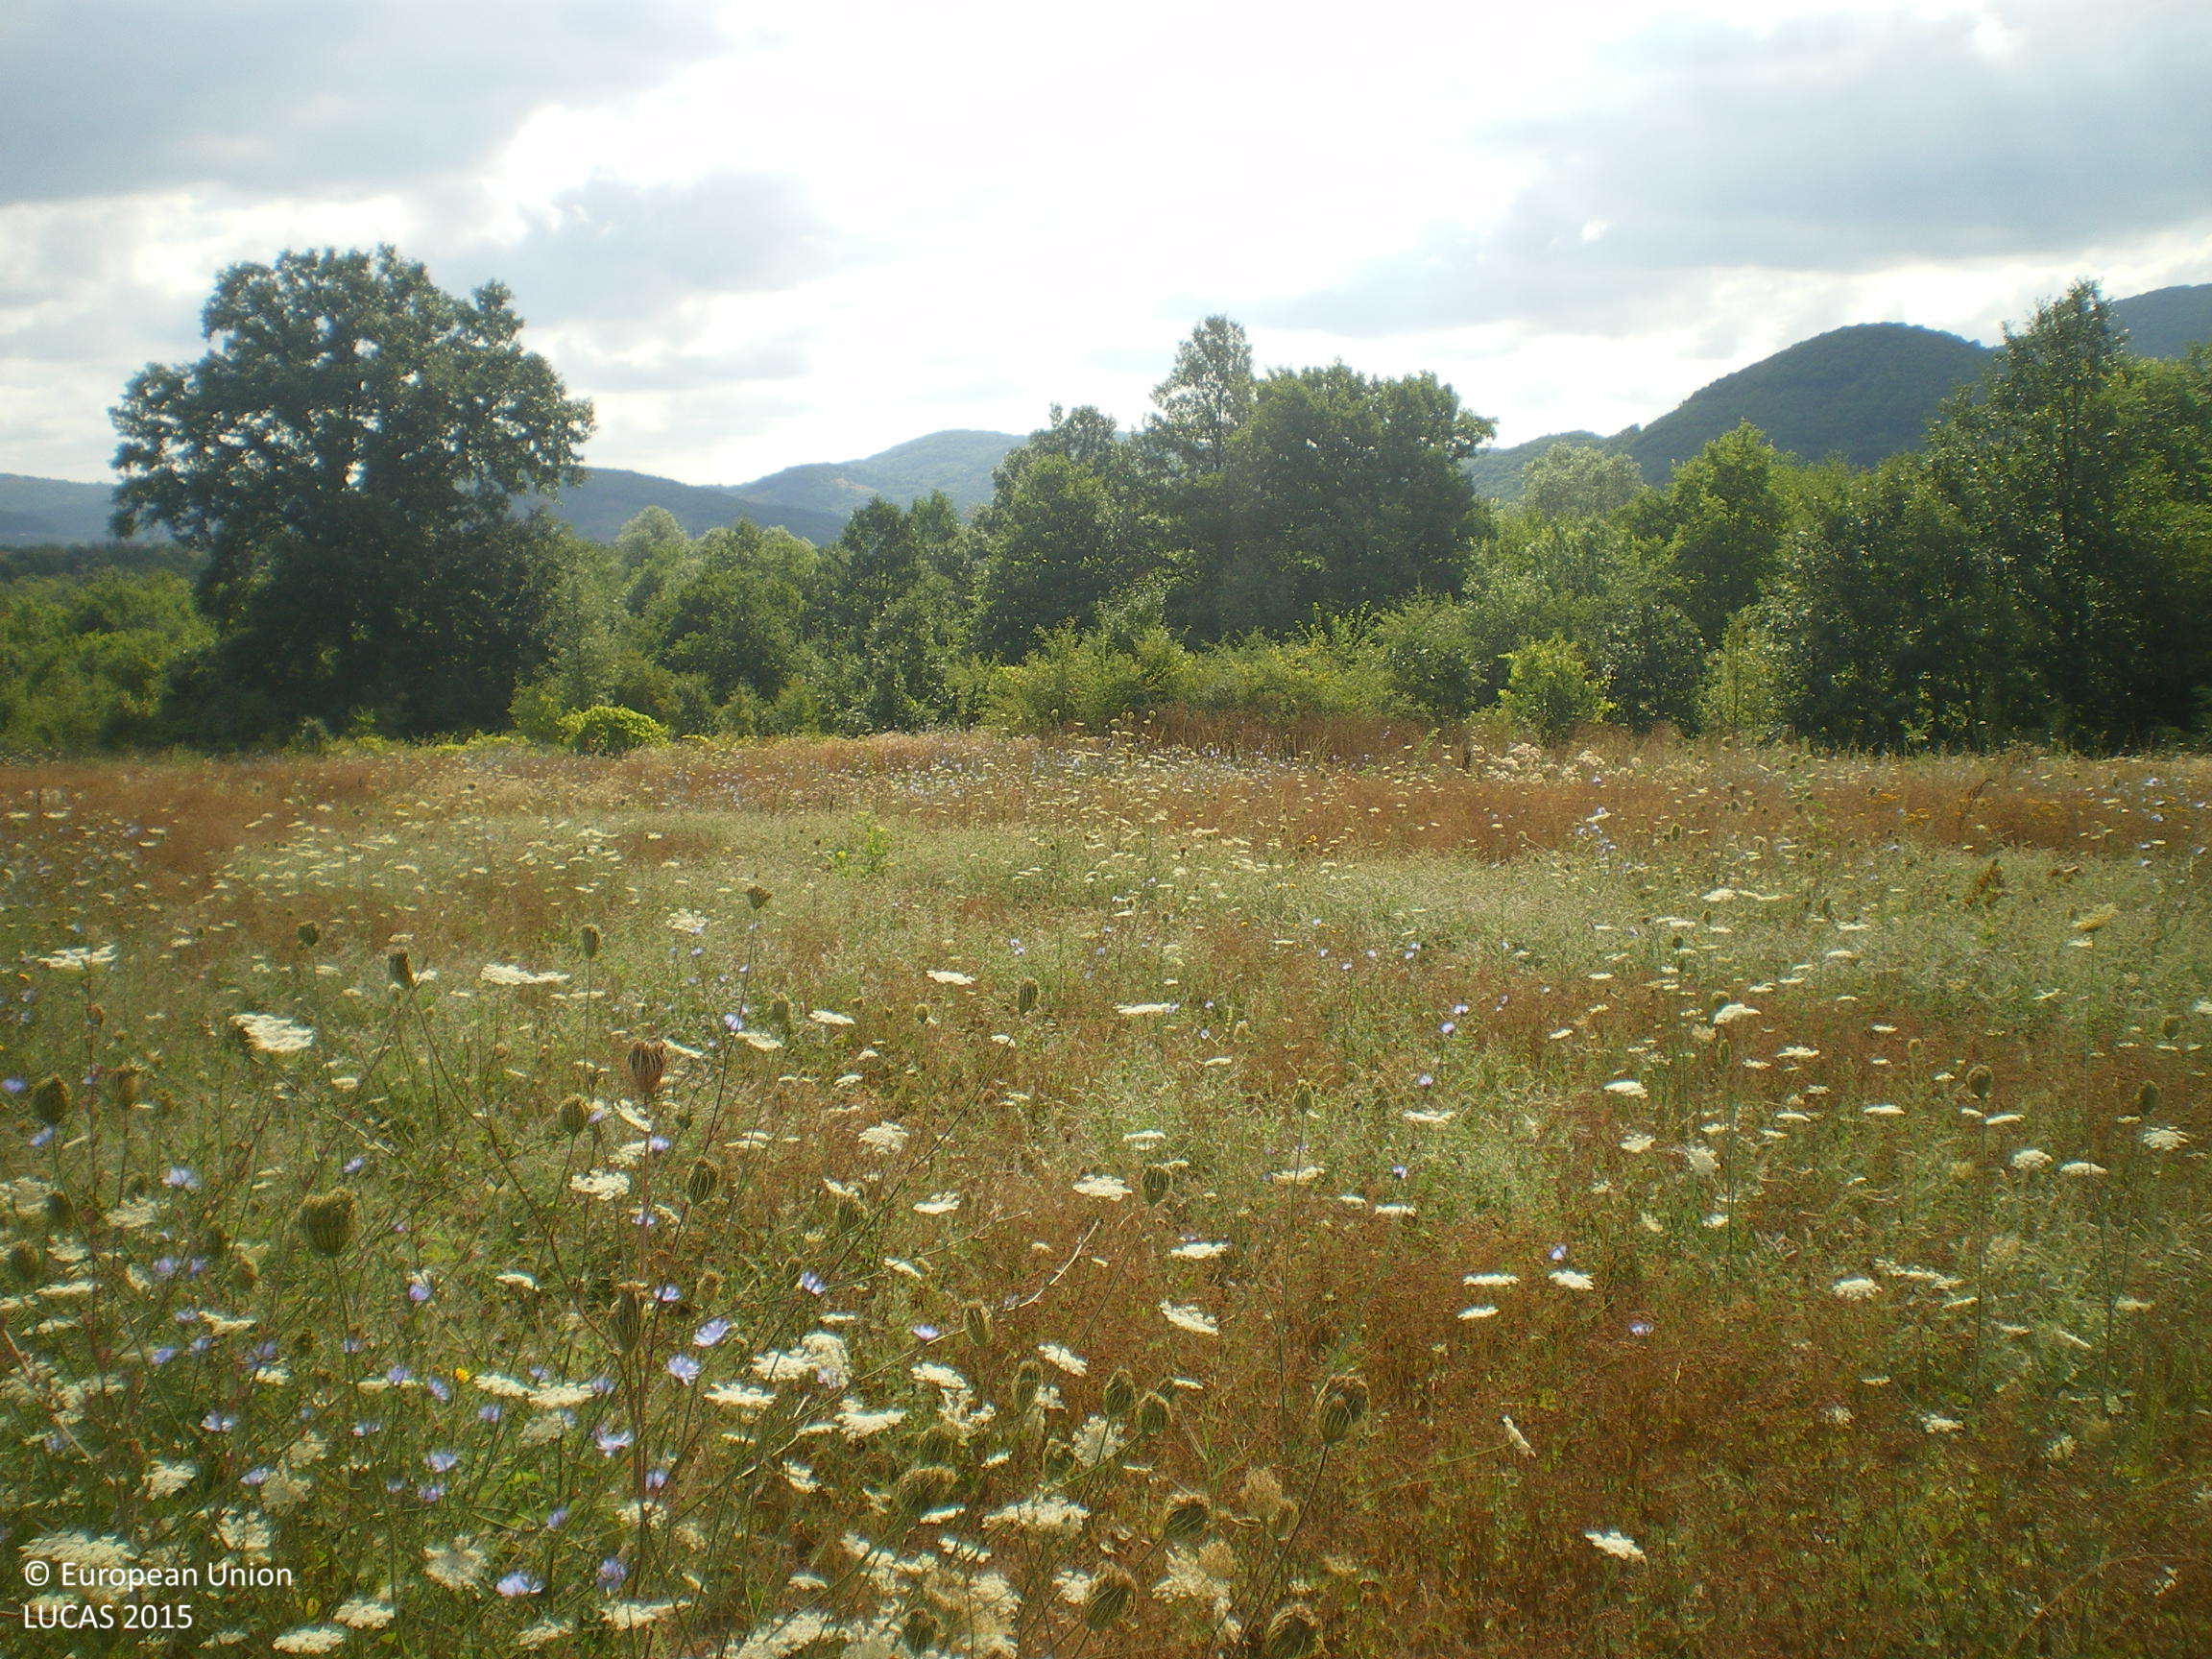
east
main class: Grassland
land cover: Spontaneously vegetated surfaces
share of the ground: > 75 %
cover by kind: herbaceous plants 100 %
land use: Fallow land
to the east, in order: Spontaneously vegetated surfaces; Rivers and streams; Broadleaved woodland
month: August
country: BG
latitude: 42.4857
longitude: 25.5830
